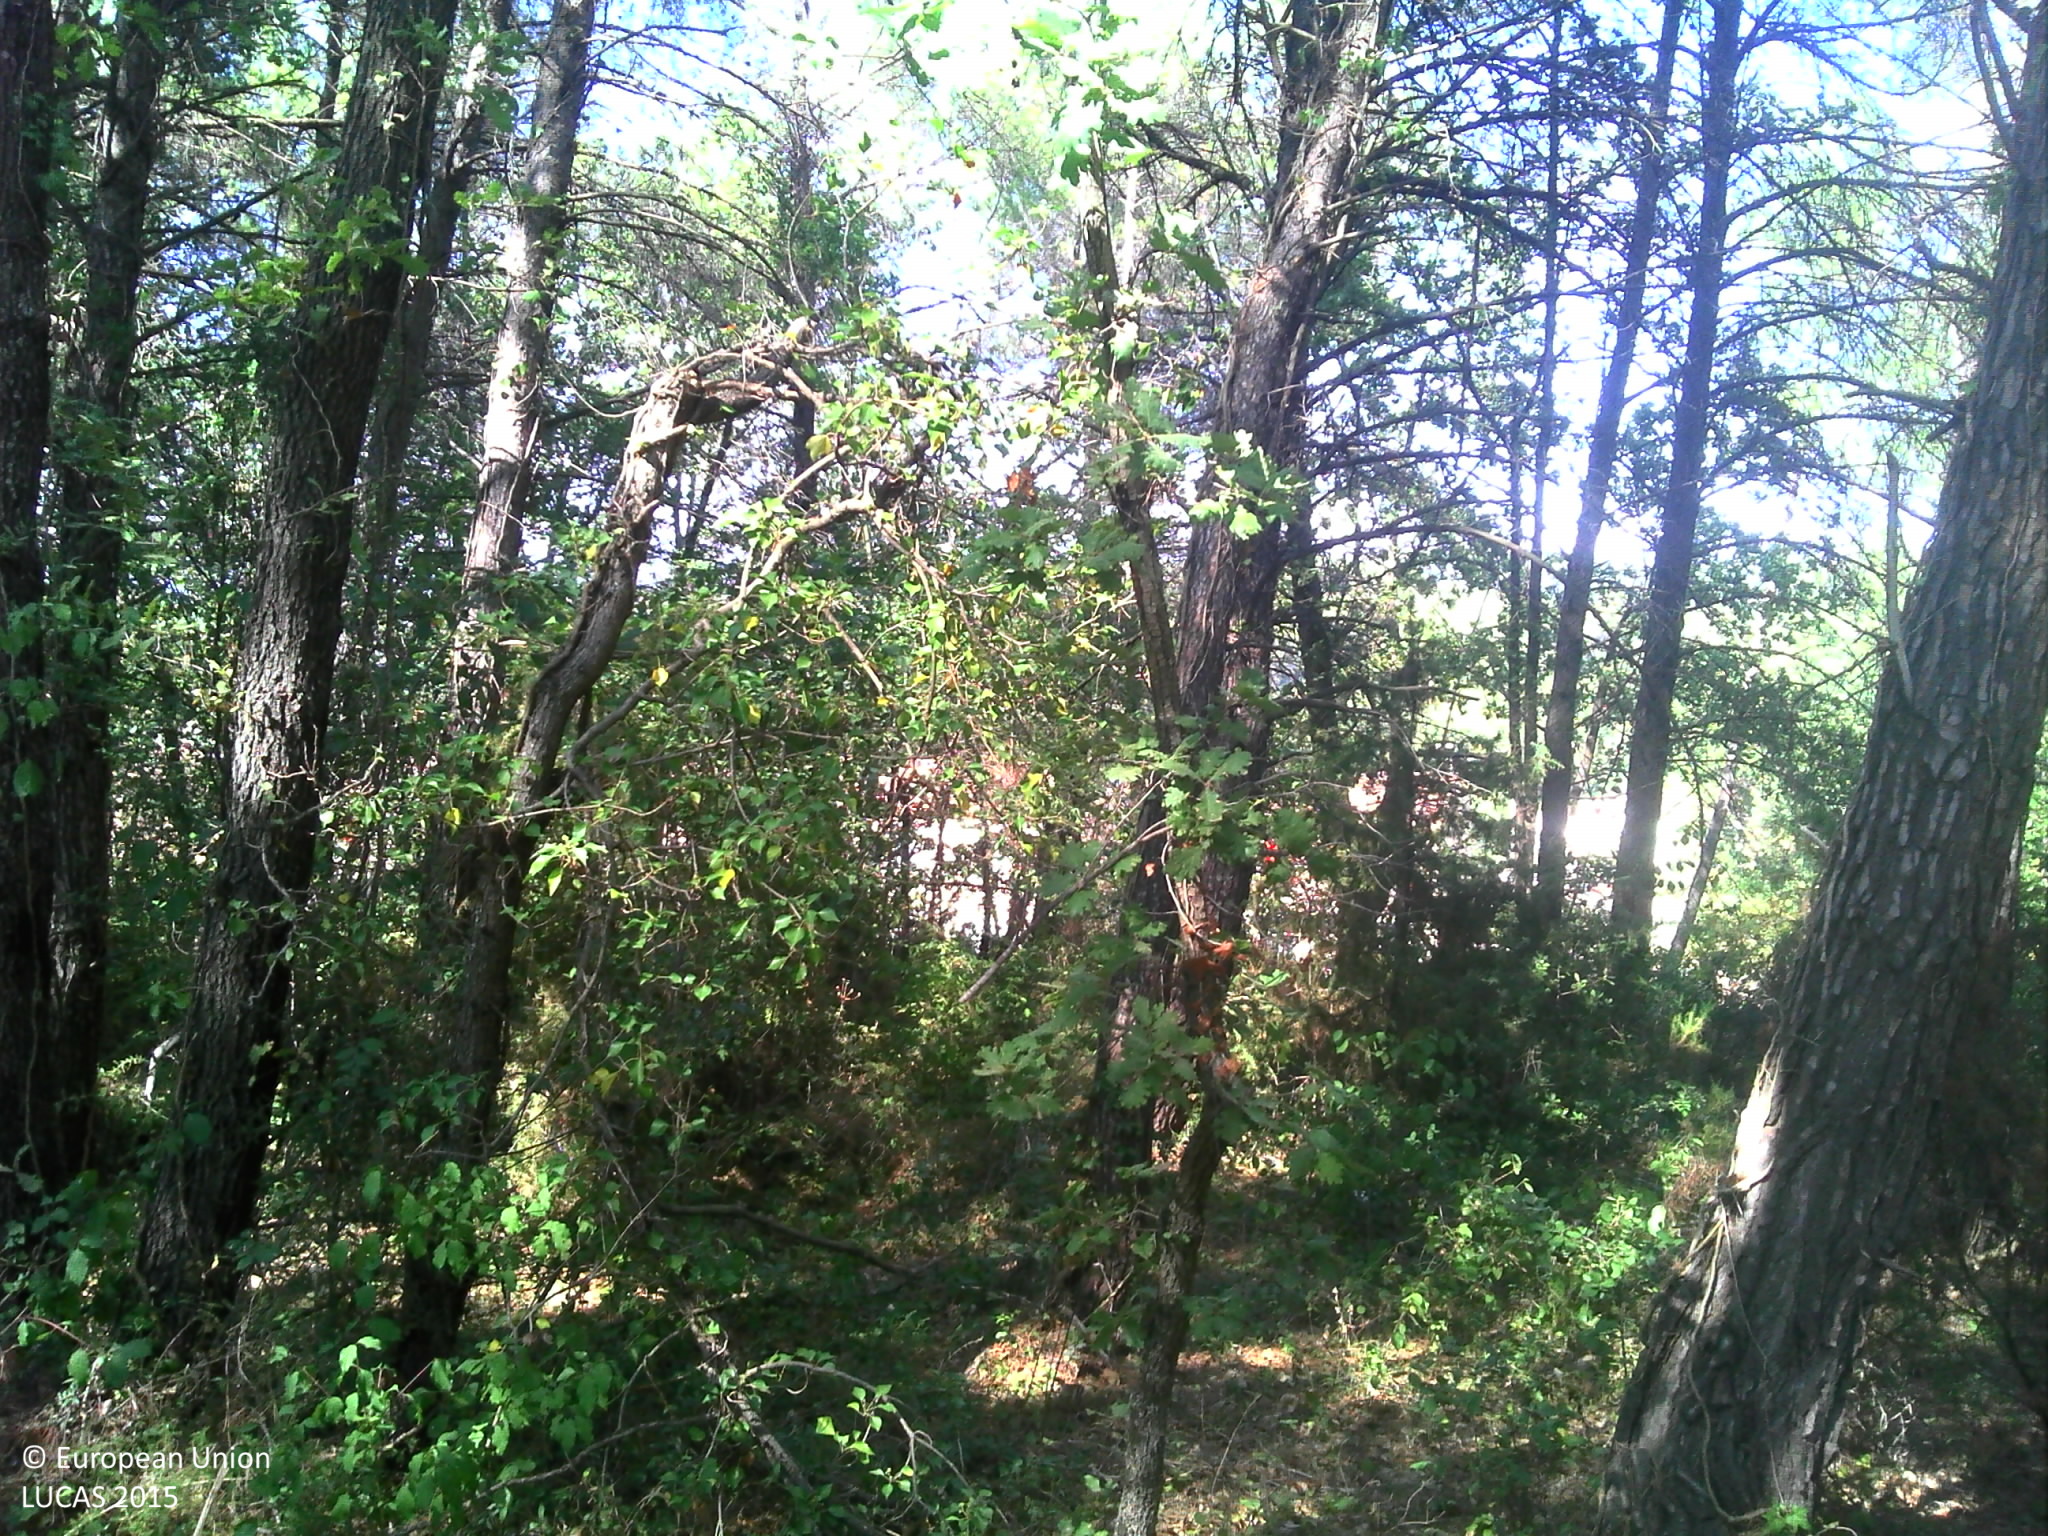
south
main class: Woodland
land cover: Pine dominated mixed woodland
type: coniferous forest of the mediterranean region
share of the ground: > 75 %
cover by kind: coniferous forest trees 50 %, broadleaved forest trees 50 %
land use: Forestry
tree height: > 5 m
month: August
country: FR
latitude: 43.3880
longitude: 5.5535
